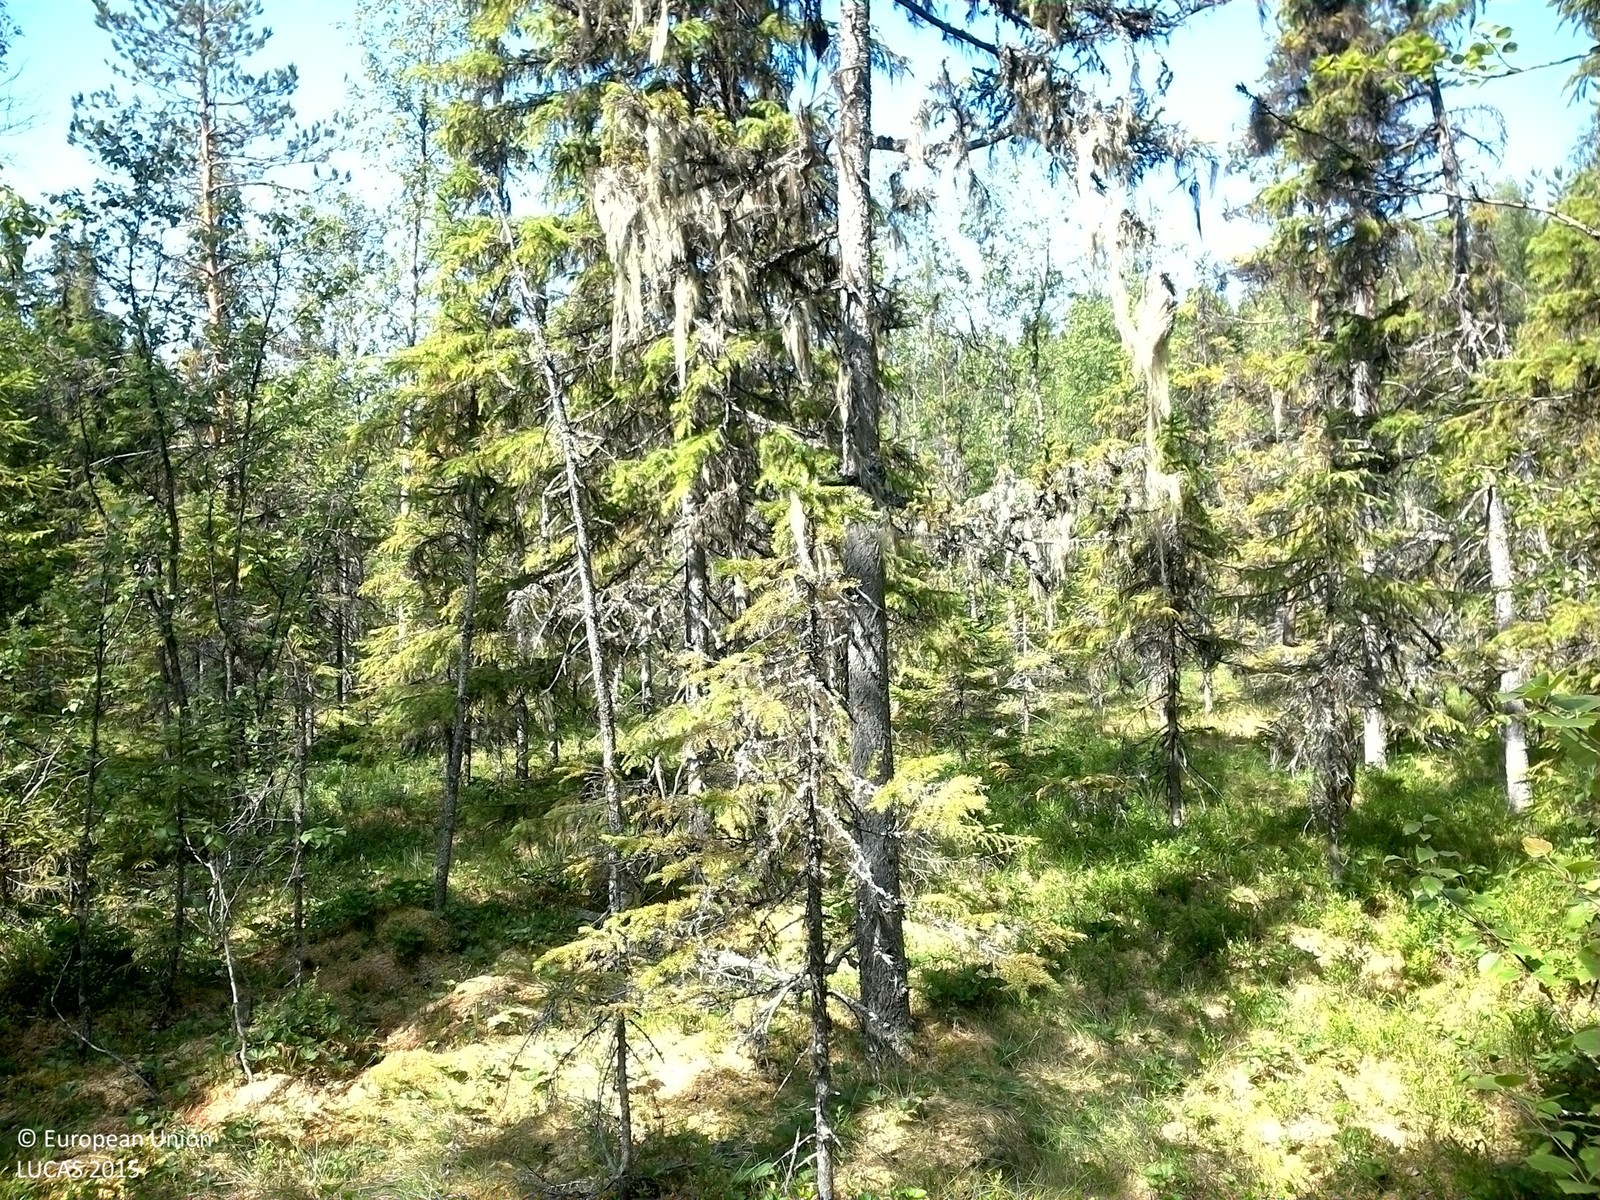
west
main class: Woodland
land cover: Spruce dominated coniferous woodland
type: boreal forest
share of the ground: 25 - 50 %
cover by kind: coniferous forest trees 35 %, lichens and mosses 30 %, shrubs 20 %, broadleaved forest trees 10 %, herbaceous plants 5 %
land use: Forestry
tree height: > 5 m
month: July
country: SE
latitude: 63.4989
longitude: 17.7882
